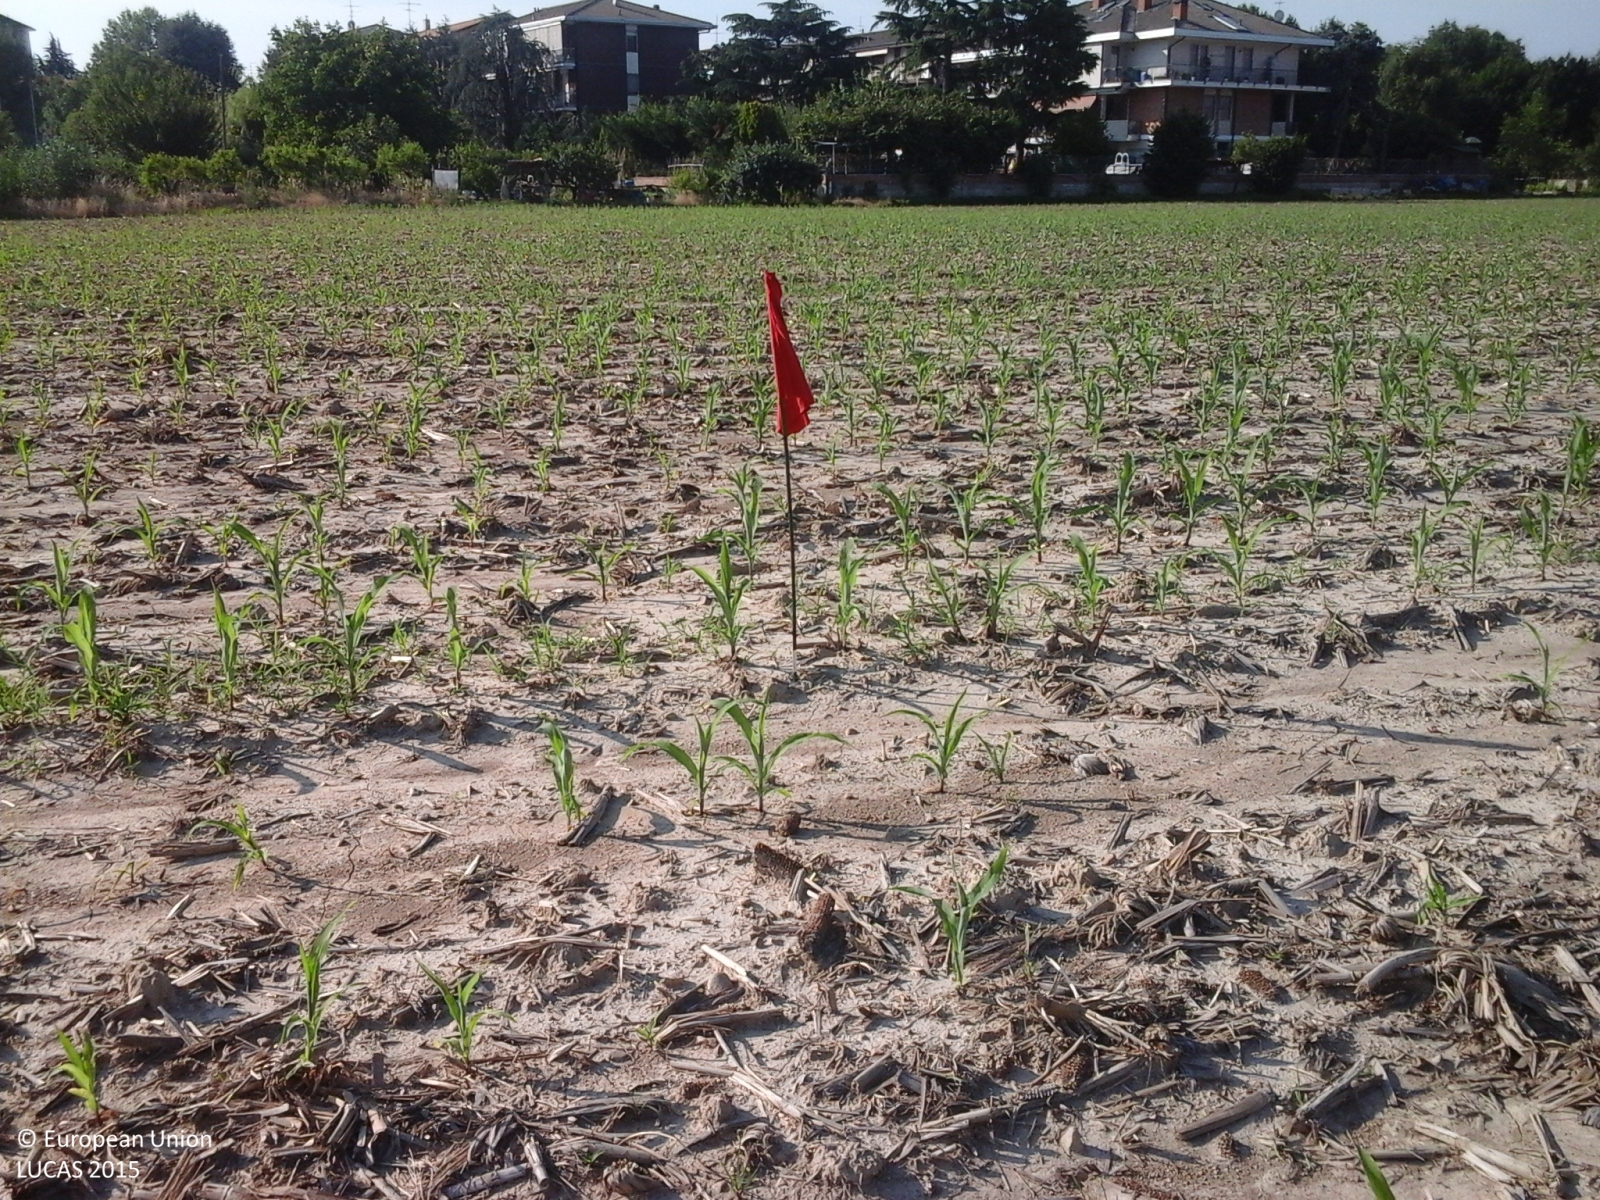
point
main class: Cropland
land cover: Maize
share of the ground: 10 - 25 %
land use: Agriculture (excluding fallow land and kitchen gardens)
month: June
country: IT
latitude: 45.4595
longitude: 8.6339
